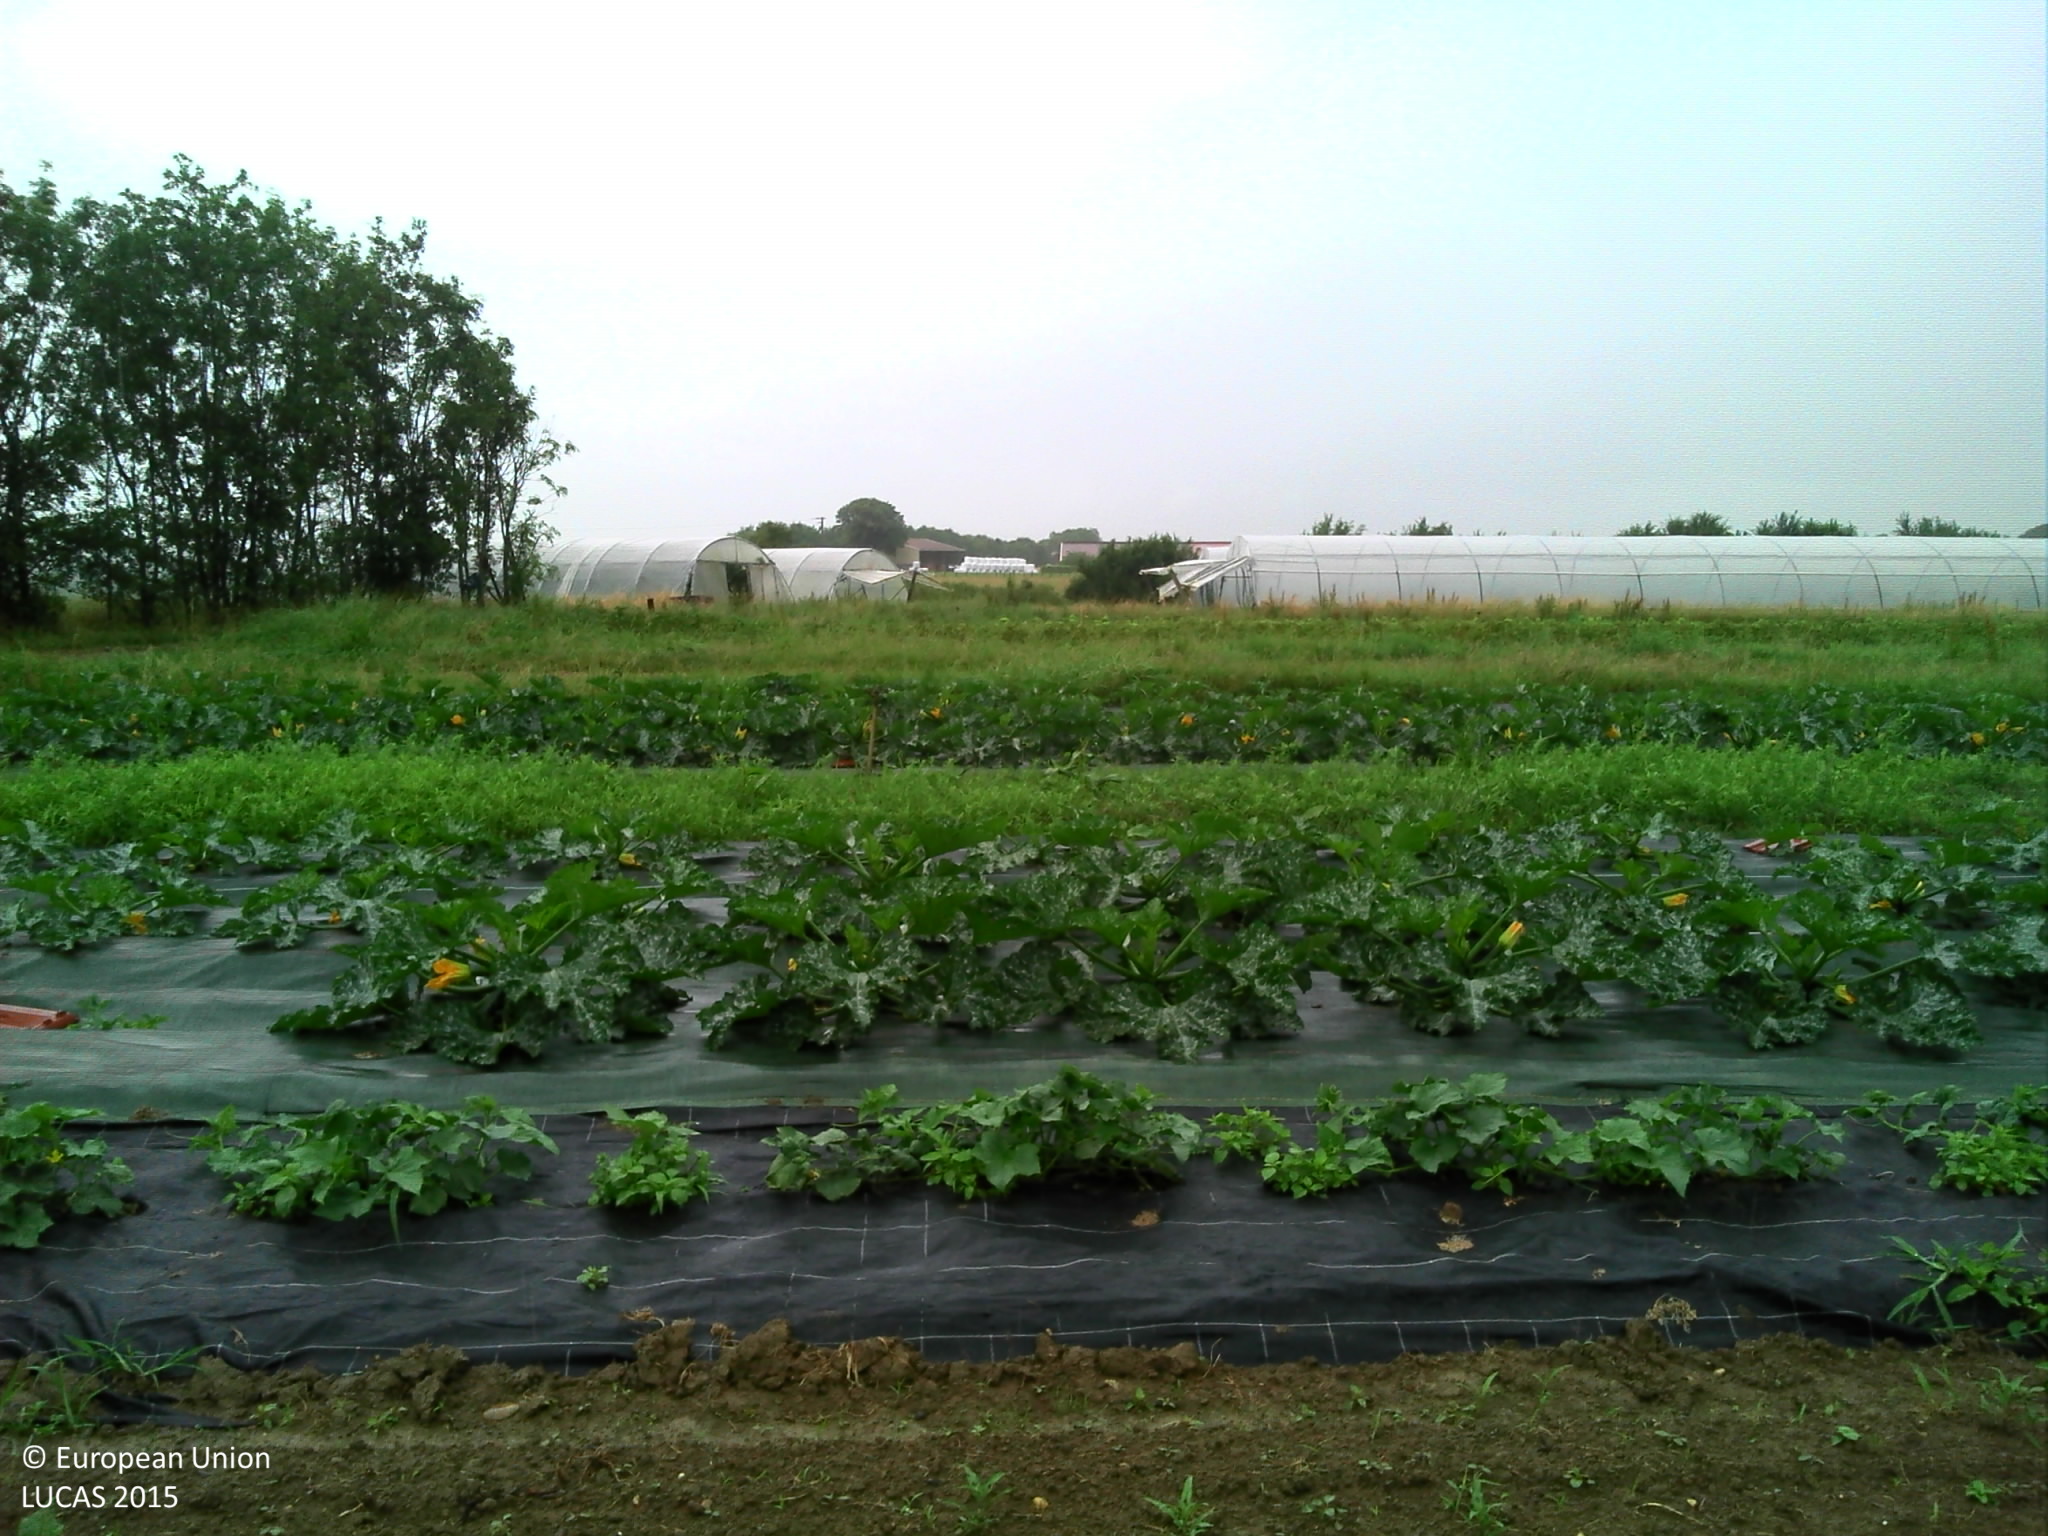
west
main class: Cropland
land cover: Other fresh vegetables
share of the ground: 50 - 75 %
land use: Agriculture (excluding fallow land and kitchen gardens)
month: June
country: FR
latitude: 46.9945
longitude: 5.4650
